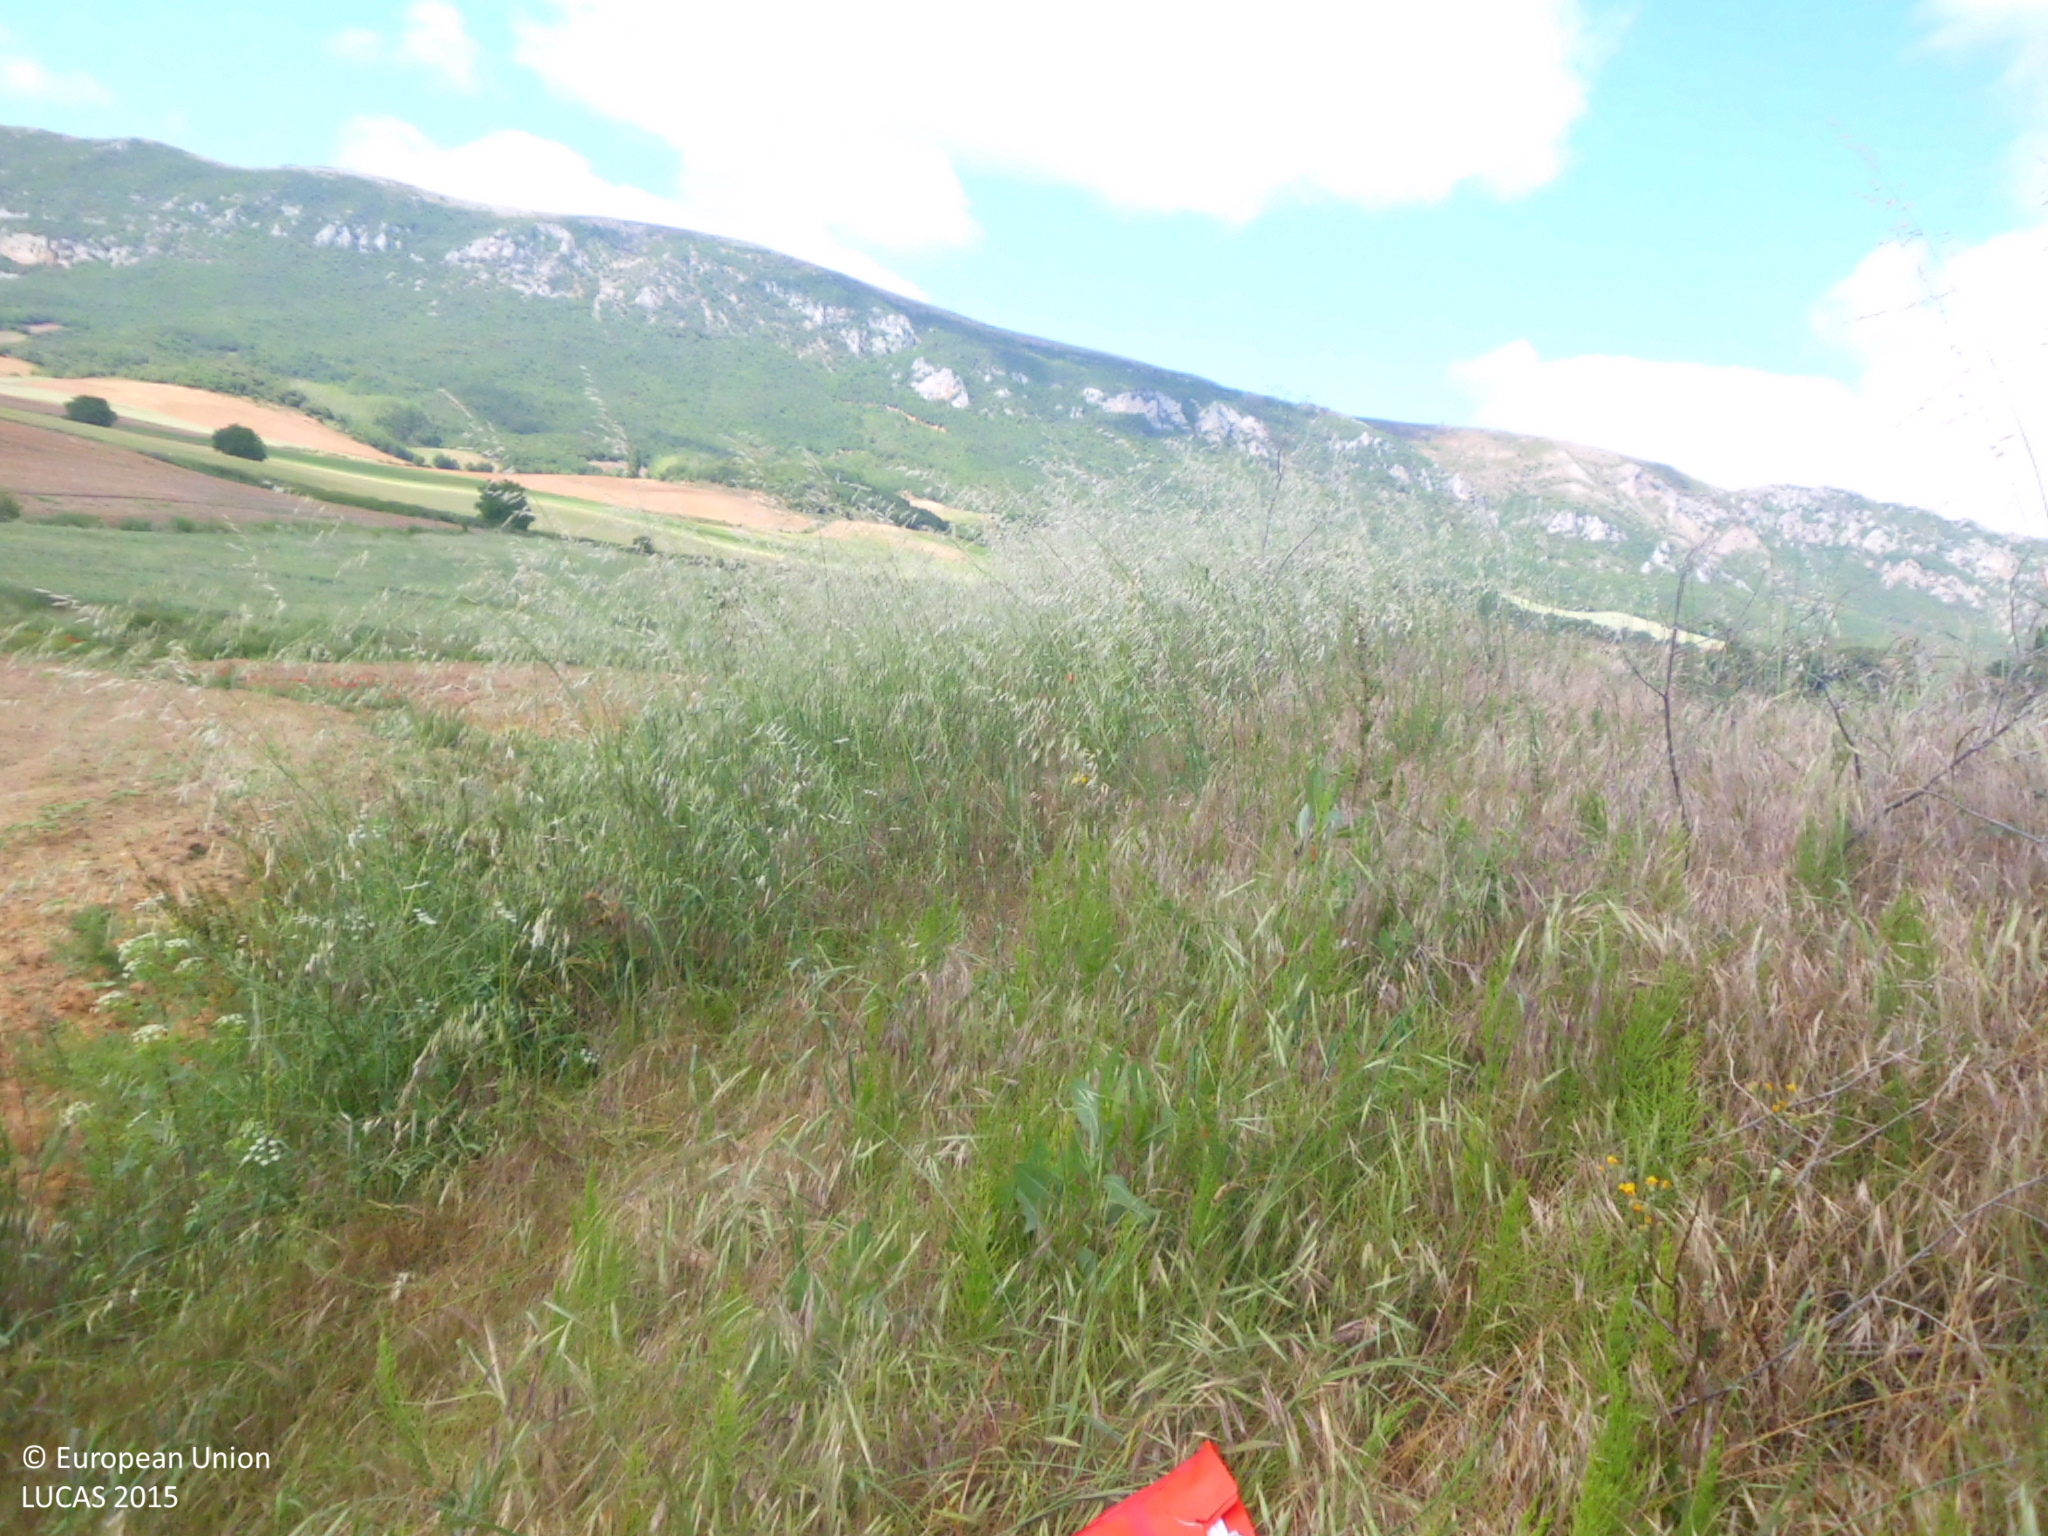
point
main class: Grassland
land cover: Grassland with sparse tree/shrub cover
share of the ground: > 75 %
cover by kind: herbaceous plants 80 %, consolidated bare surface 15 %, broadleaved forest trees 5 %
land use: Agriculture (excluding fallow land and kitchen gardens)
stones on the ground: < 10 %
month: June
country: ES
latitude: 42.6799
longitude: -3.3486
